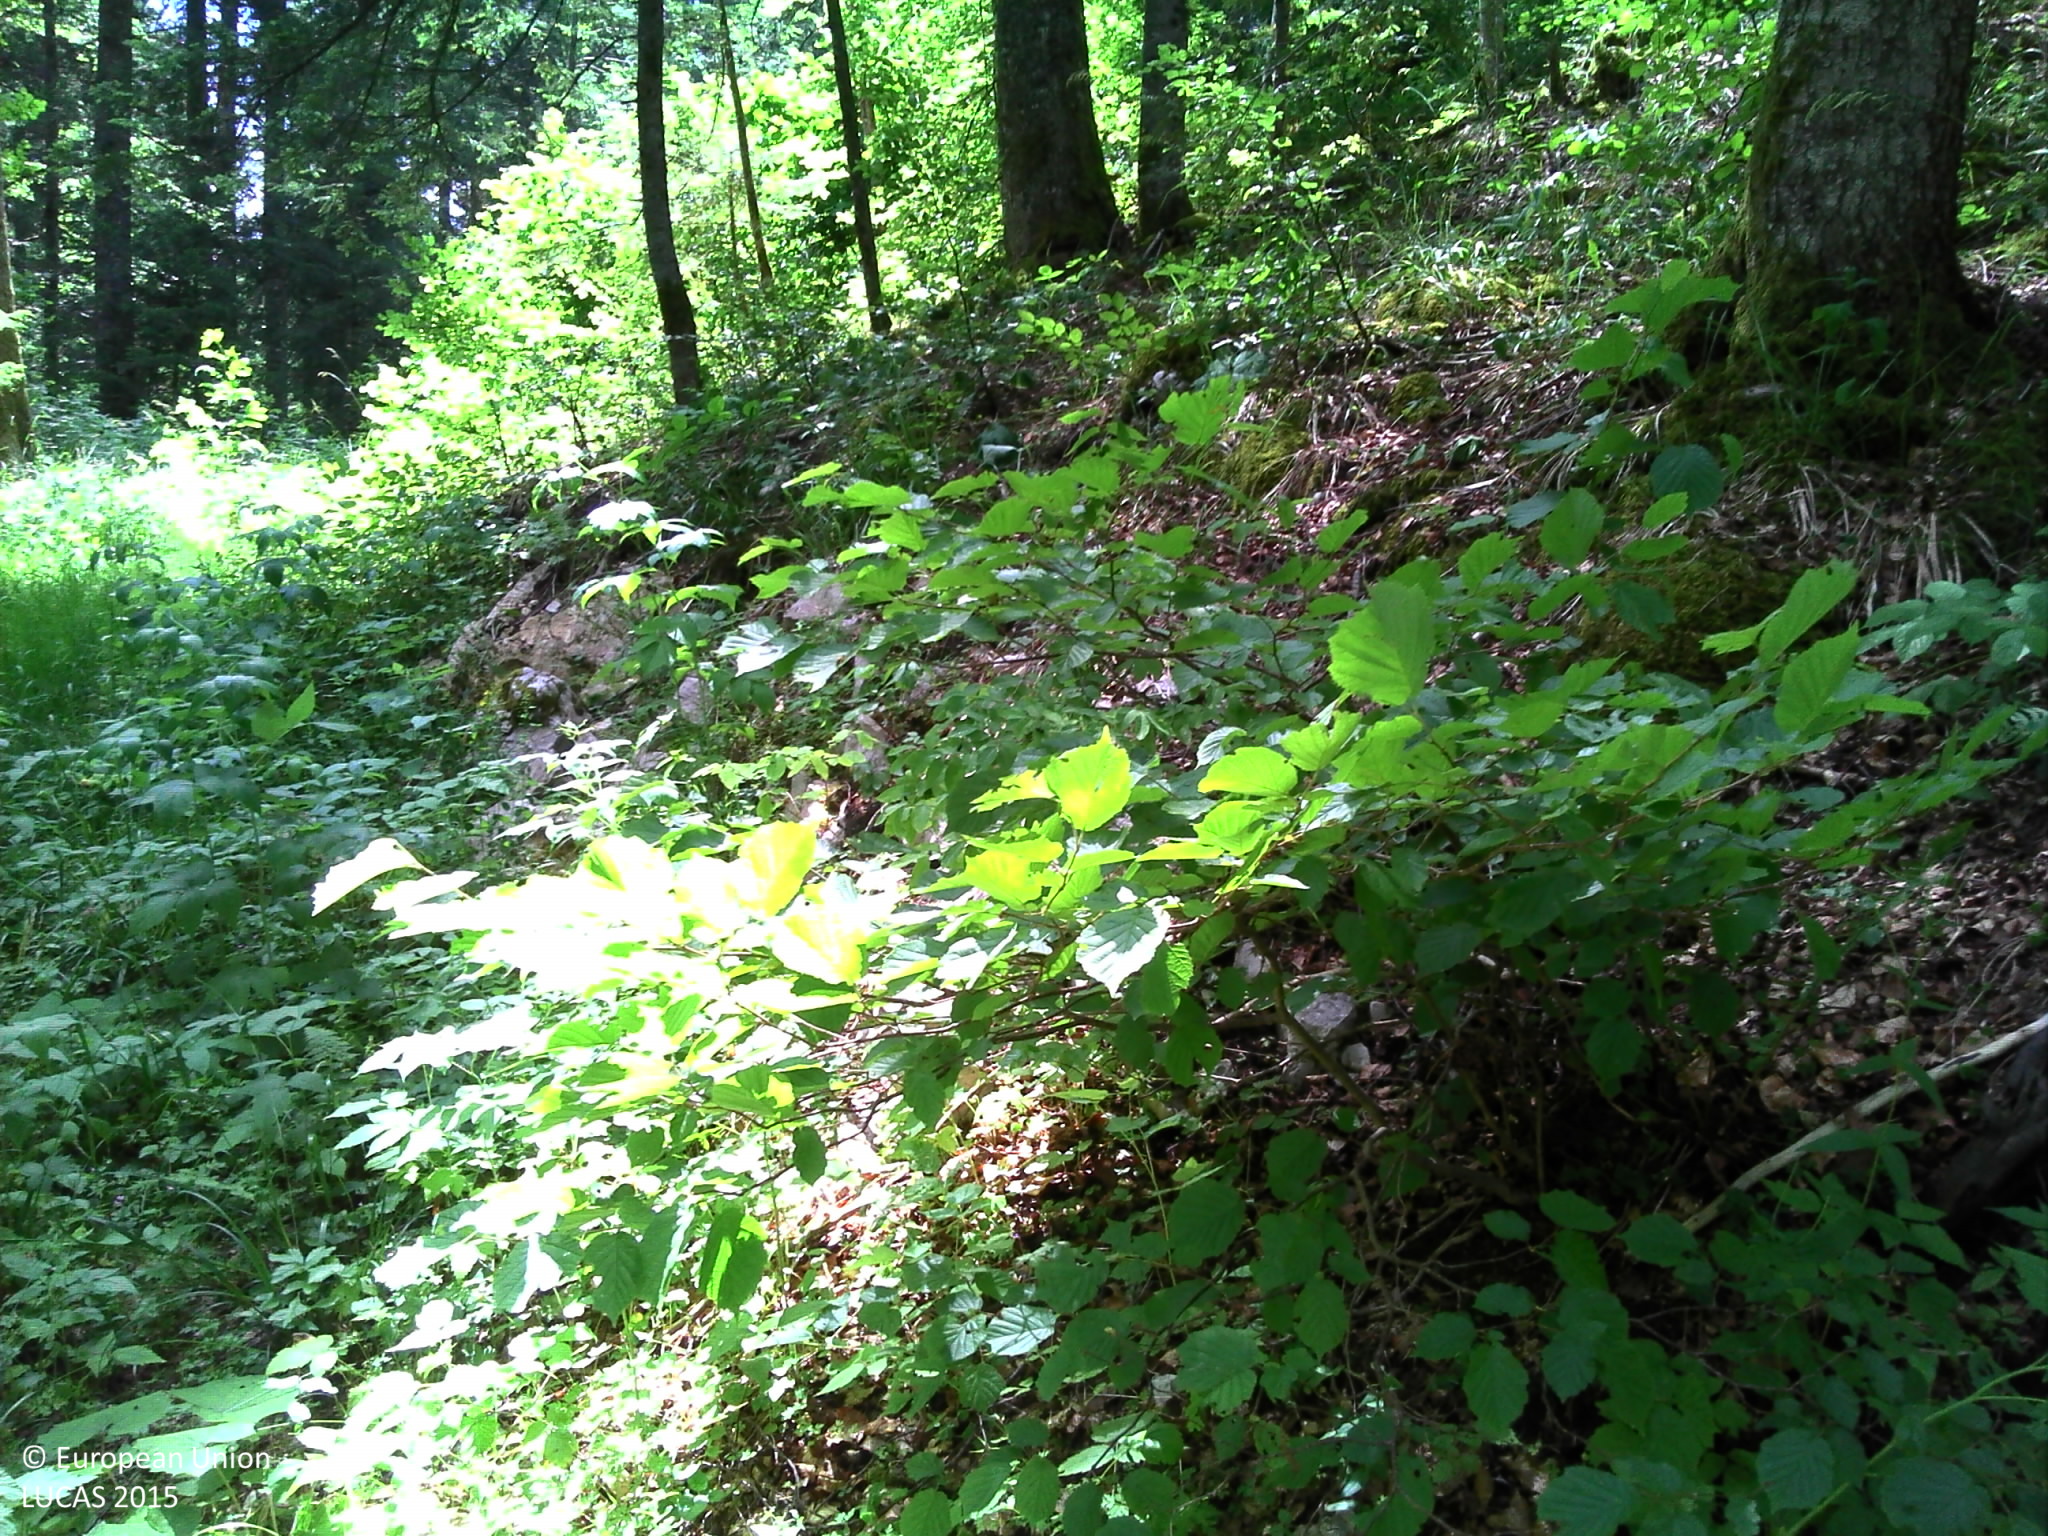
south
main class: Woodland
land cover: Spruce dominated mixed woodland
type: mountainous beech forest
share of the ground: > 75 %
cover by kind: coniferous forest trees 30 %, broadleaved forest trees 30 %, shrubs 10 %, herbaceous plants 10 %, lichens and mosses 10 %, consolidated bare surface 10 %
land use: Forestry
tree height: > 5 m
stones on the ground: > 50 %
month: July
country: FR
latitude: 46.7324
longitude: 6.1422
